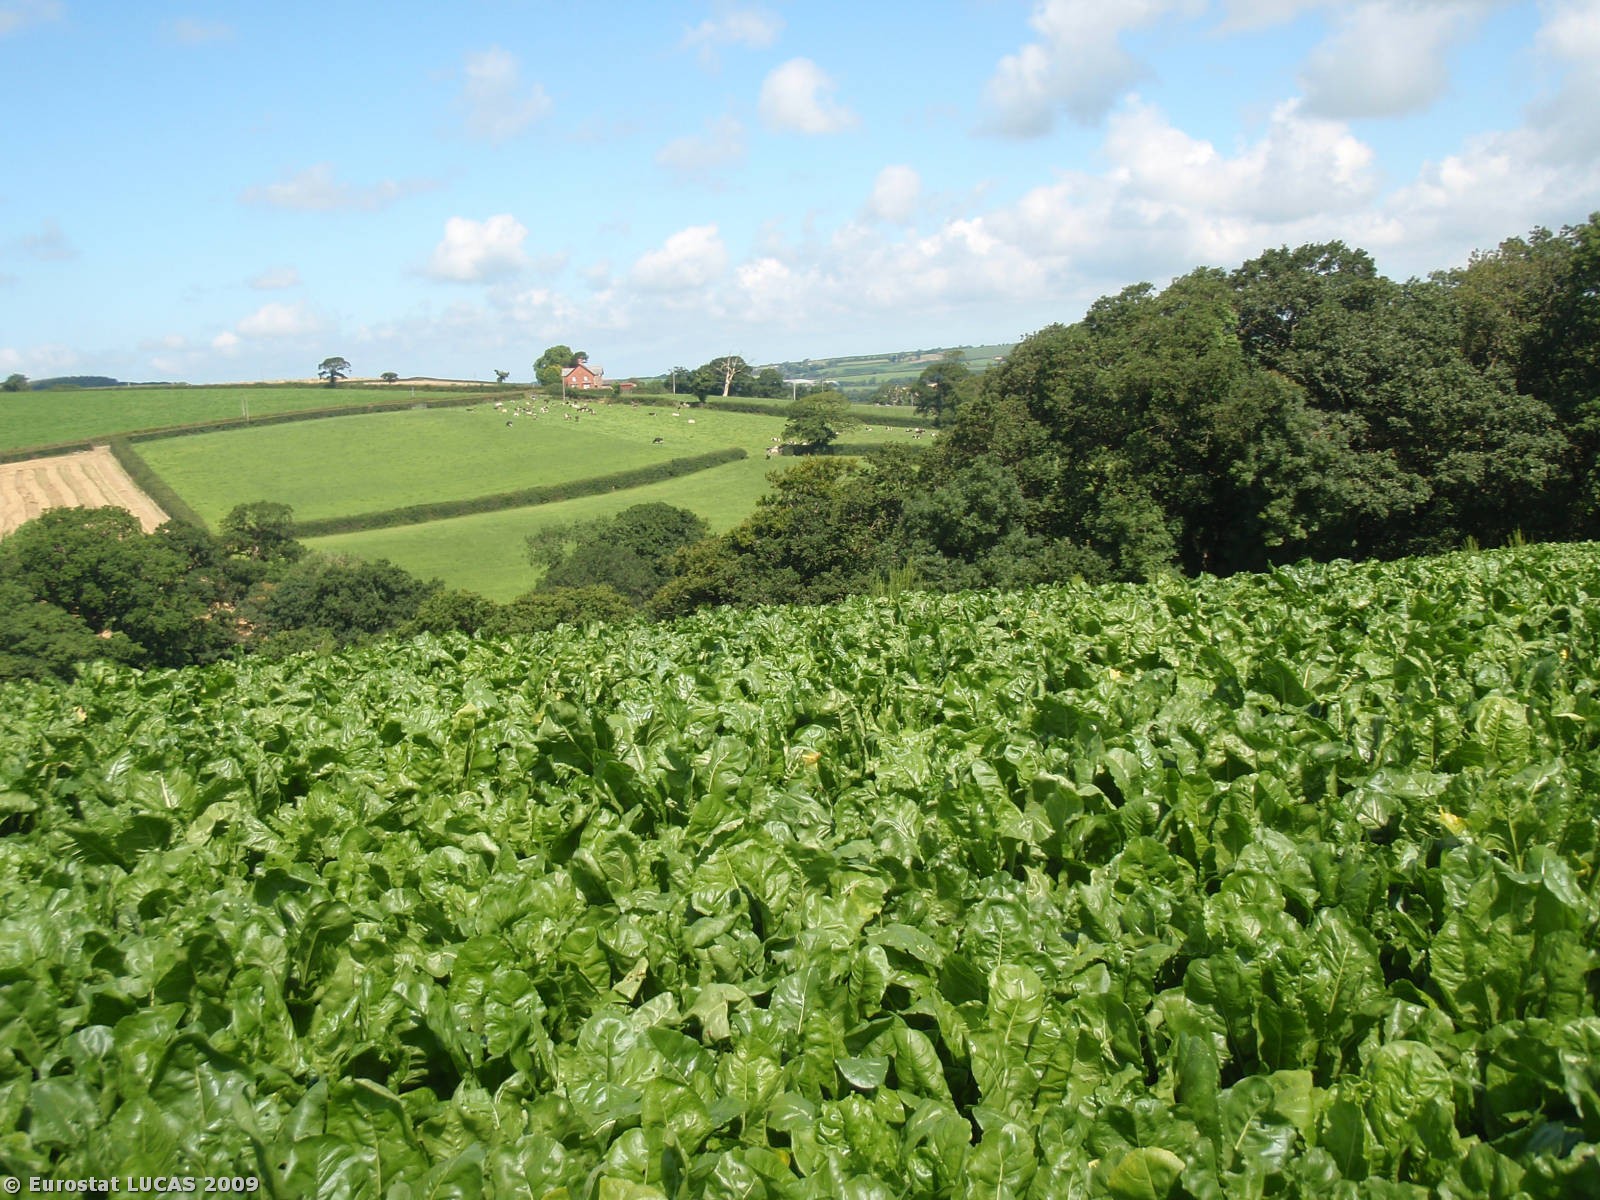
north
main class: Woodland
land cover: Broadleaved woodland
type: mesophytic deciduous forest
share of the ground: > 75 %
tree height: > 5 m
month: August
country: GB
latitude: 50.6769
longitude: -4.3518
